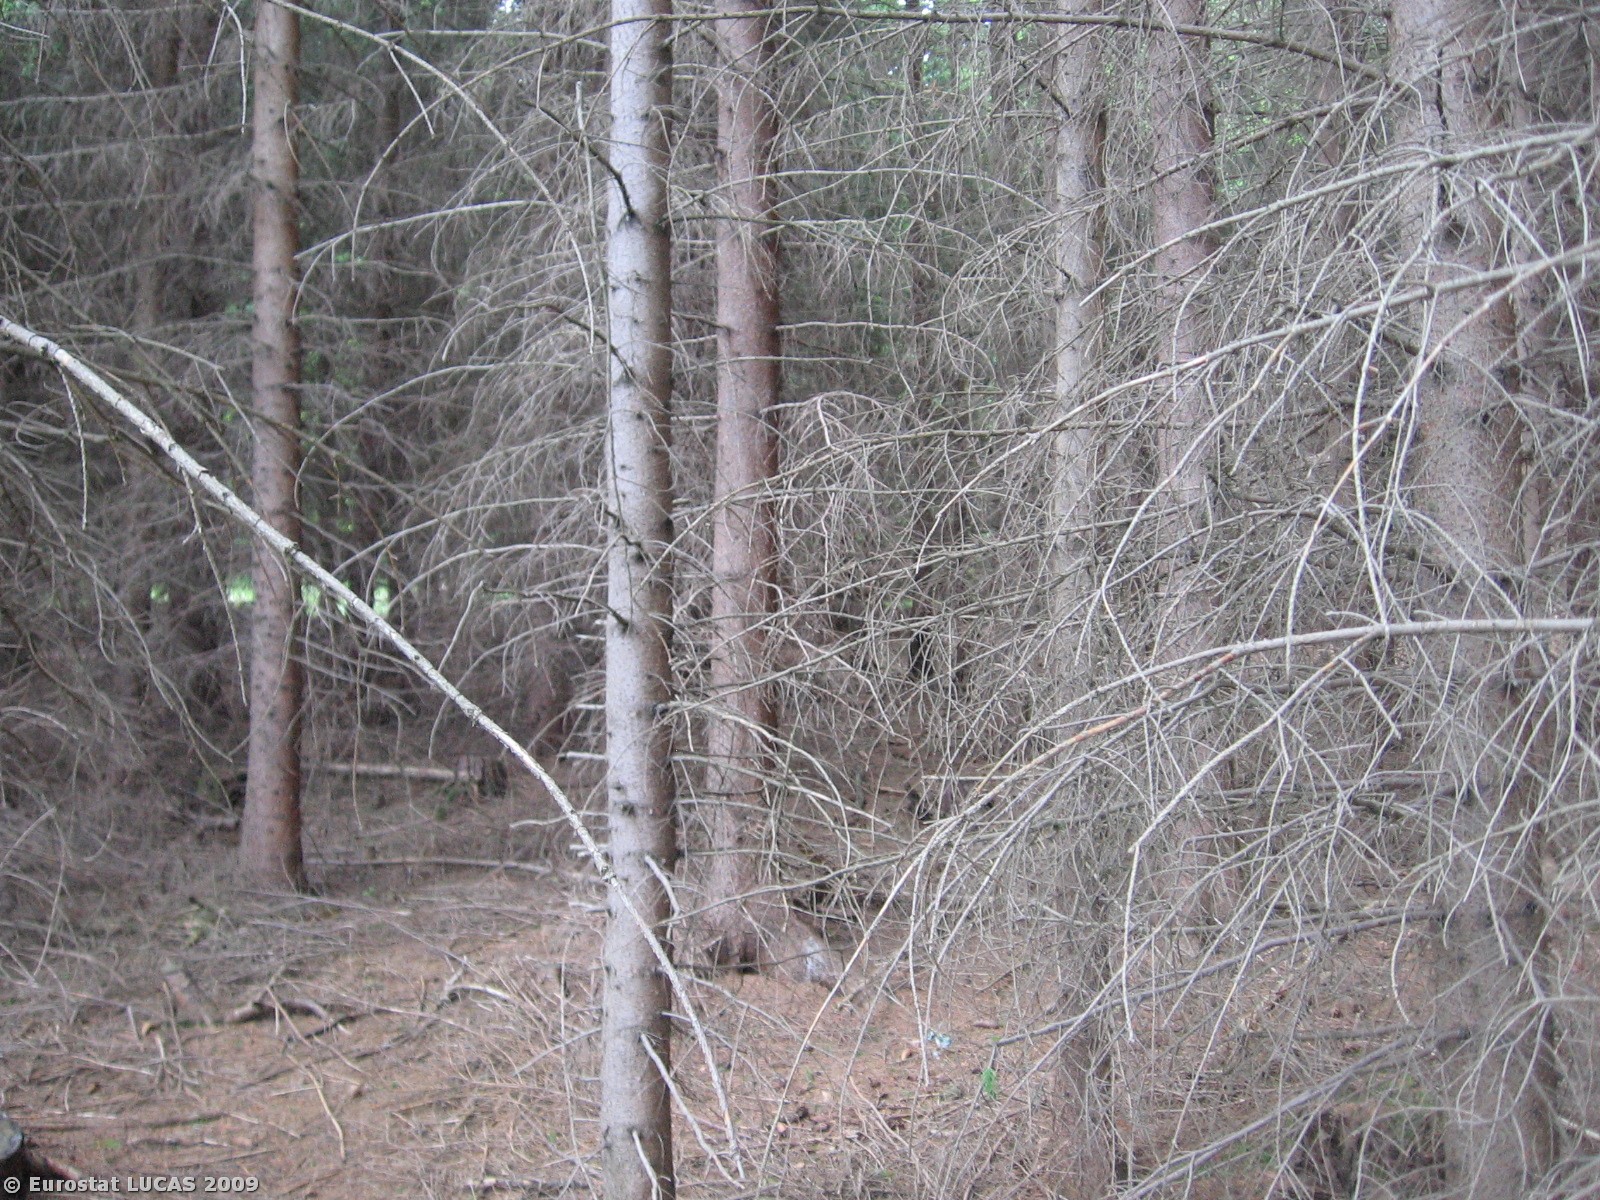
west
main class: Woodland
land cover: Coniferous woodland
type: hemiboreal forest and nemoral coniferous forest and mixed broadleaved-coniferous forest
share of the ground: > 75 %
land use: Forestry
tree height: > 5 m
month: June
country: CZ
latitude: 49.0571
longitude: 13.8456
